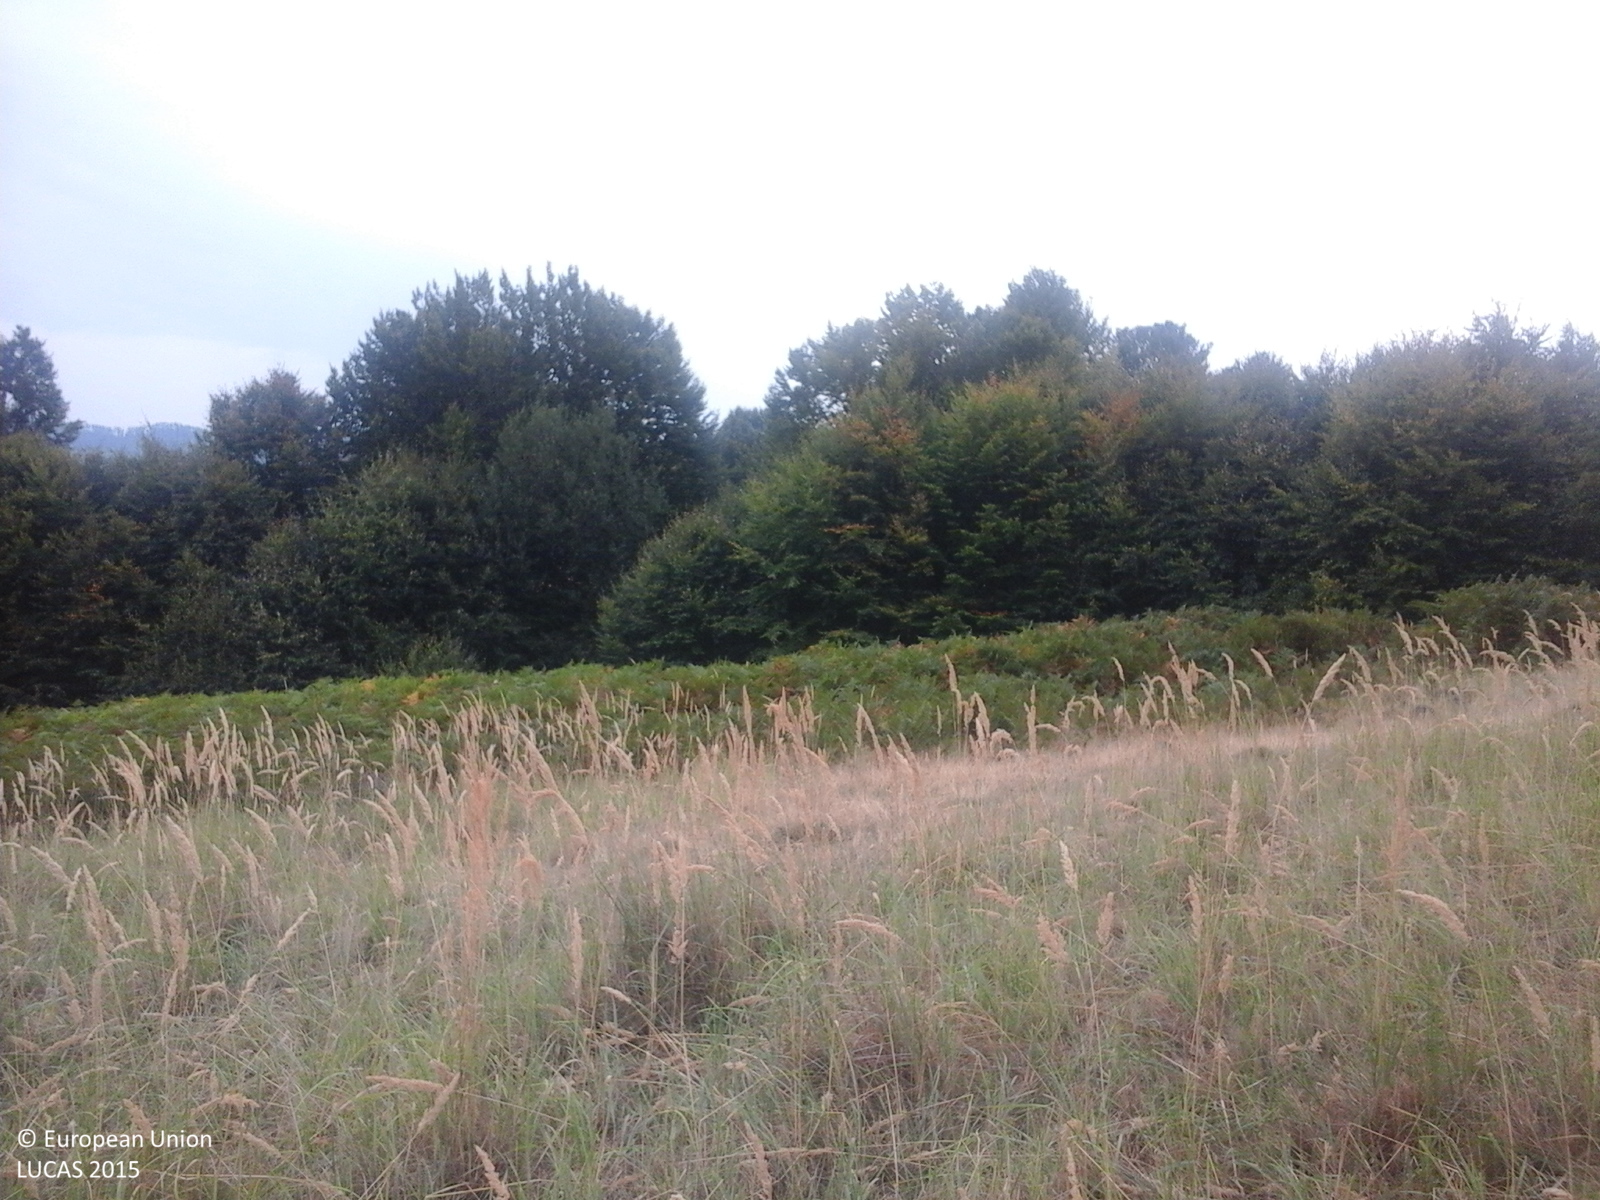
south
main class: Grassland
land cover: Grassland without tree/shrub cover
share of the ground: > 75 %
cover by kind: herbaceous plants 100 %
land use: Agriculture (excluding fallow land and kitchen gardens)
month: September
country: RO
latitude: 47.9785
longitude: 23.5959
